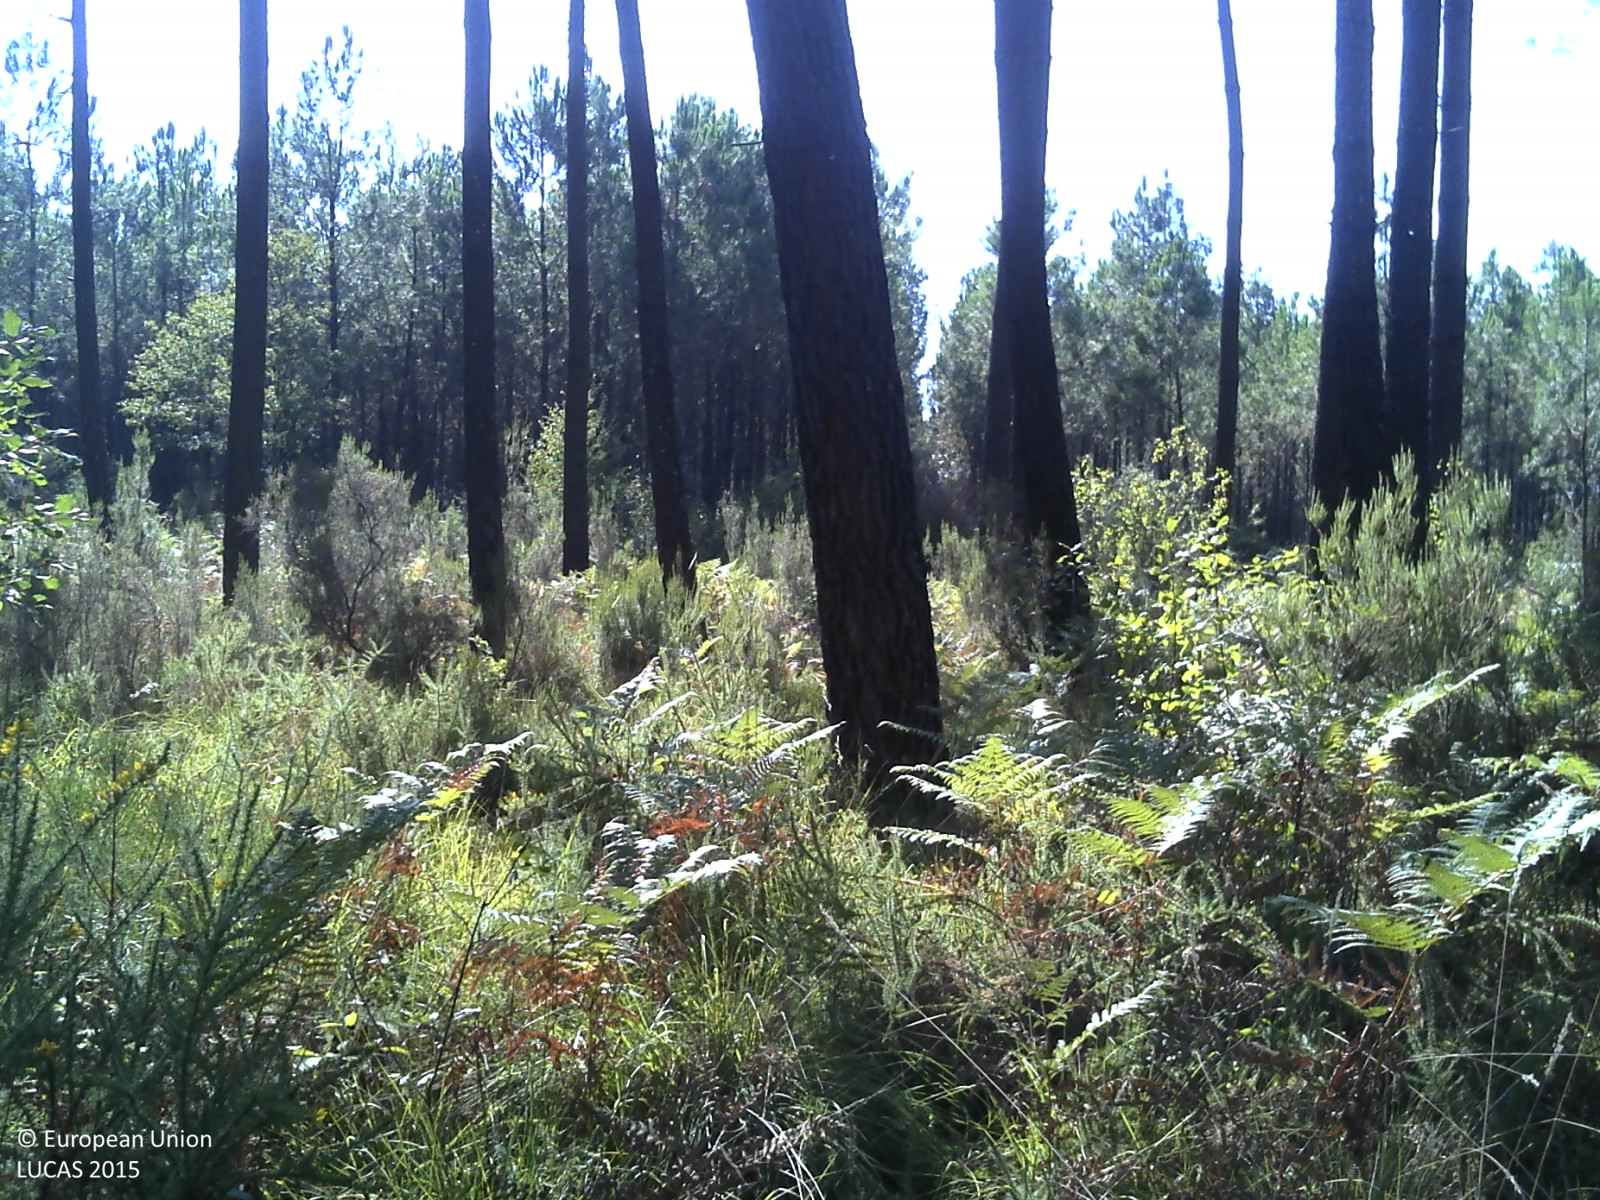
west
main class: Woodland
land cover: Pine dominated coniferous woodland
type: coniferous forest of the mediterranean region
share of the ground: > 75 %
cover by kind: coniferous forest trees 60 %, shrubs 30 %, herbaceous plants 5 %, lichens and mosses 5 %
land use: Forestry
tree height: > 5 m
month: August
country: FR
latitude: 44.5407
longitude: -0.7032
